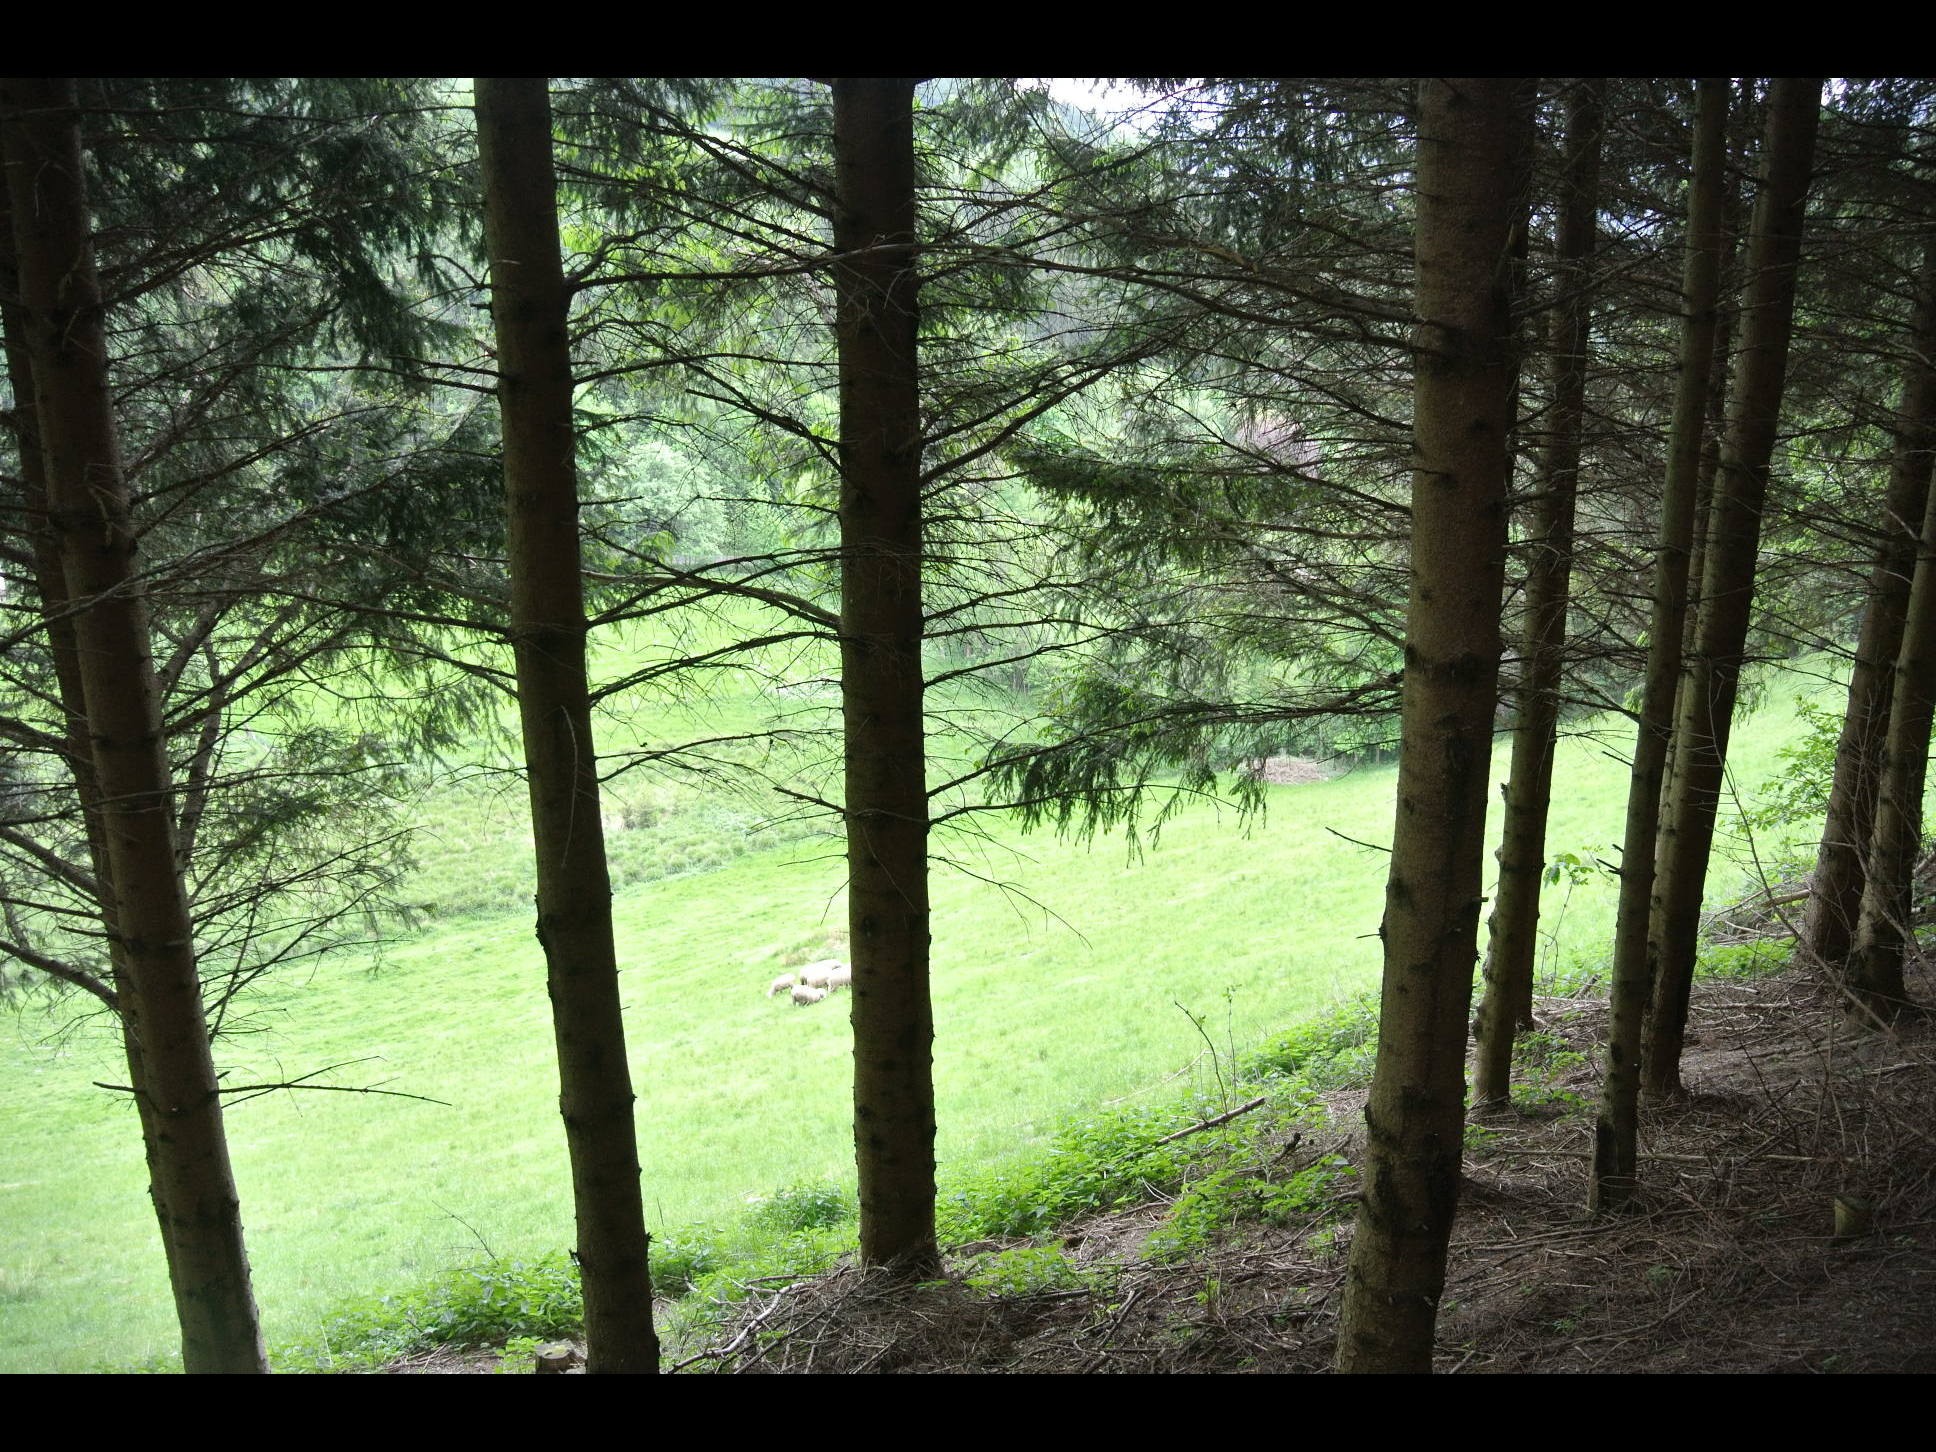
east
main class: Woodland
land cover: Spruce dominated coniferous woodland
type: alpine coniferous forest
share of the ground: > 75 %
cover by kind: coniferous forest trees 100 %
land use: Forestry
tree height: > 5 m
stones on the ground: 10 - 25 %
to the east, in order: Spruce dominated coniferous woodland; Grassland without tree/shrub cover; Fences; Broadleaved woodland; Rivers and streams; Broadleaved woodland; Electric lines; Paved roads, cycling and walking lanes; Shruby margins; Electric lines; Fences; Spruce dominated coniferous woodland; Artificial constructions in urban areas
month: May
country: AT
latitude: 47.6770
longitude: 15.7428
